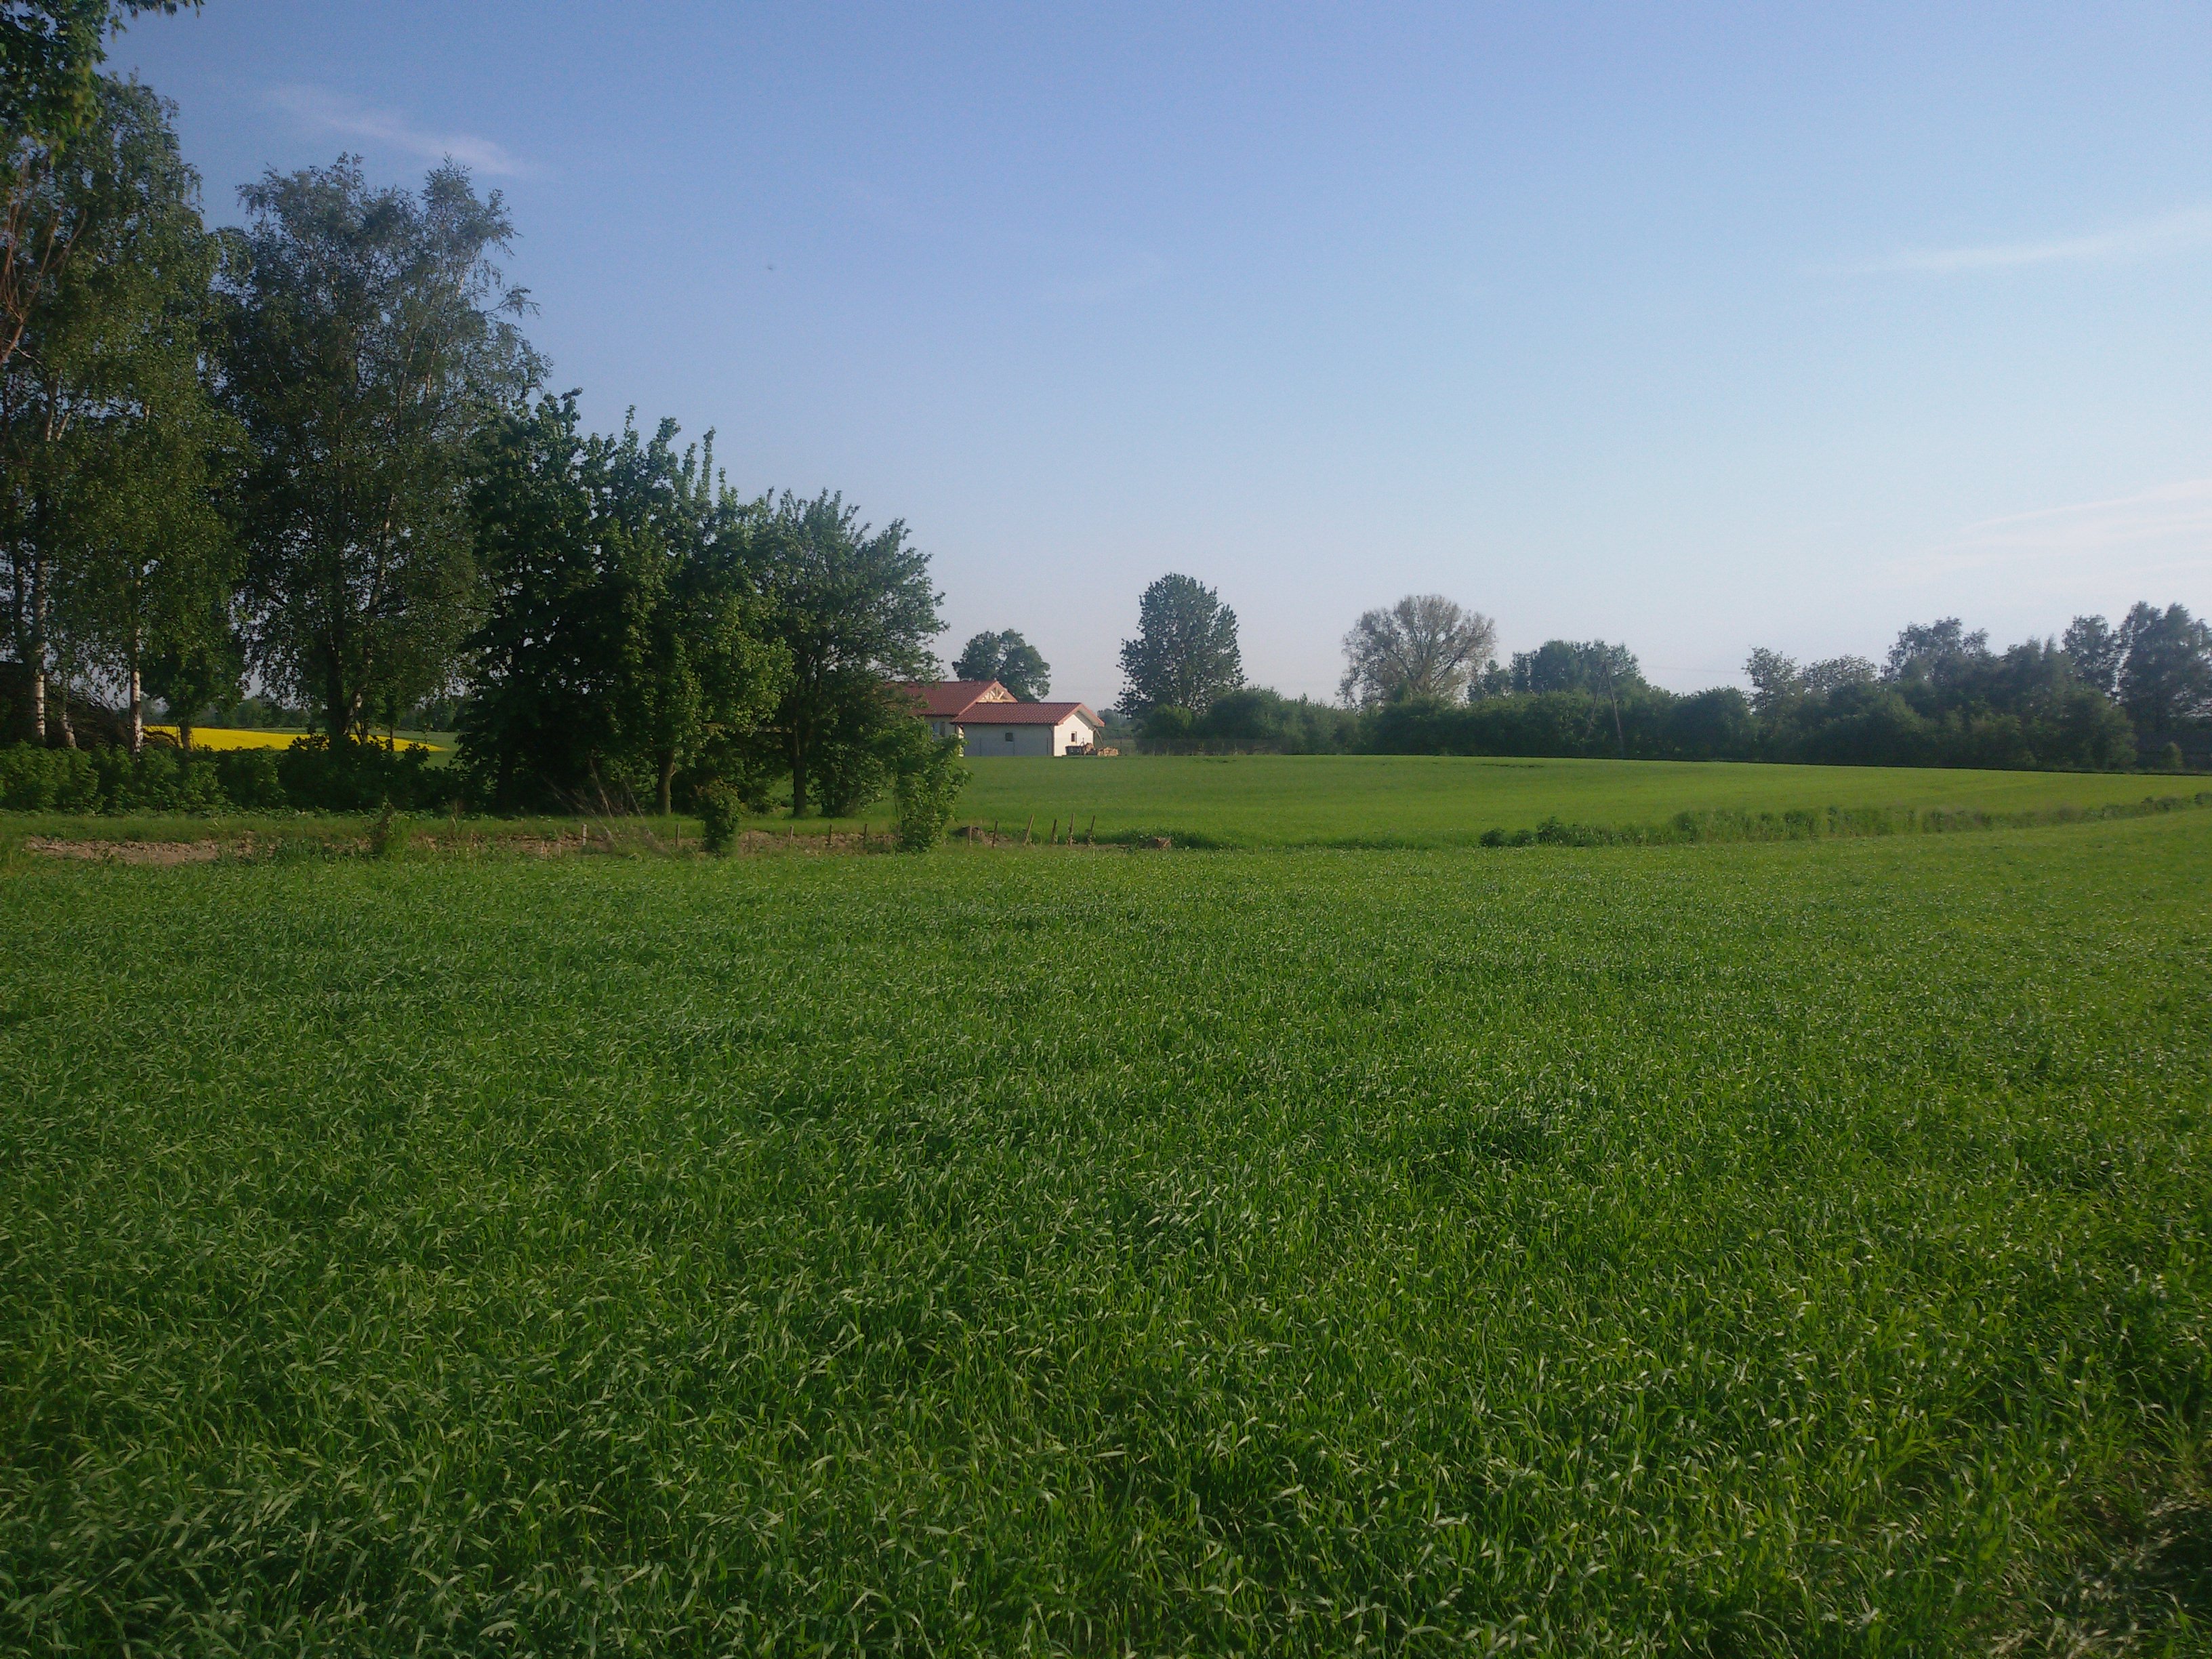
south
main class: Cropland
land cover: Common wheat
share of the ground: > 75 %
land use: Agriculture (excluding fallow land and kitchen gardens)
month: May
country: PL
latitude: 51.2513
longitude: 22.8962
